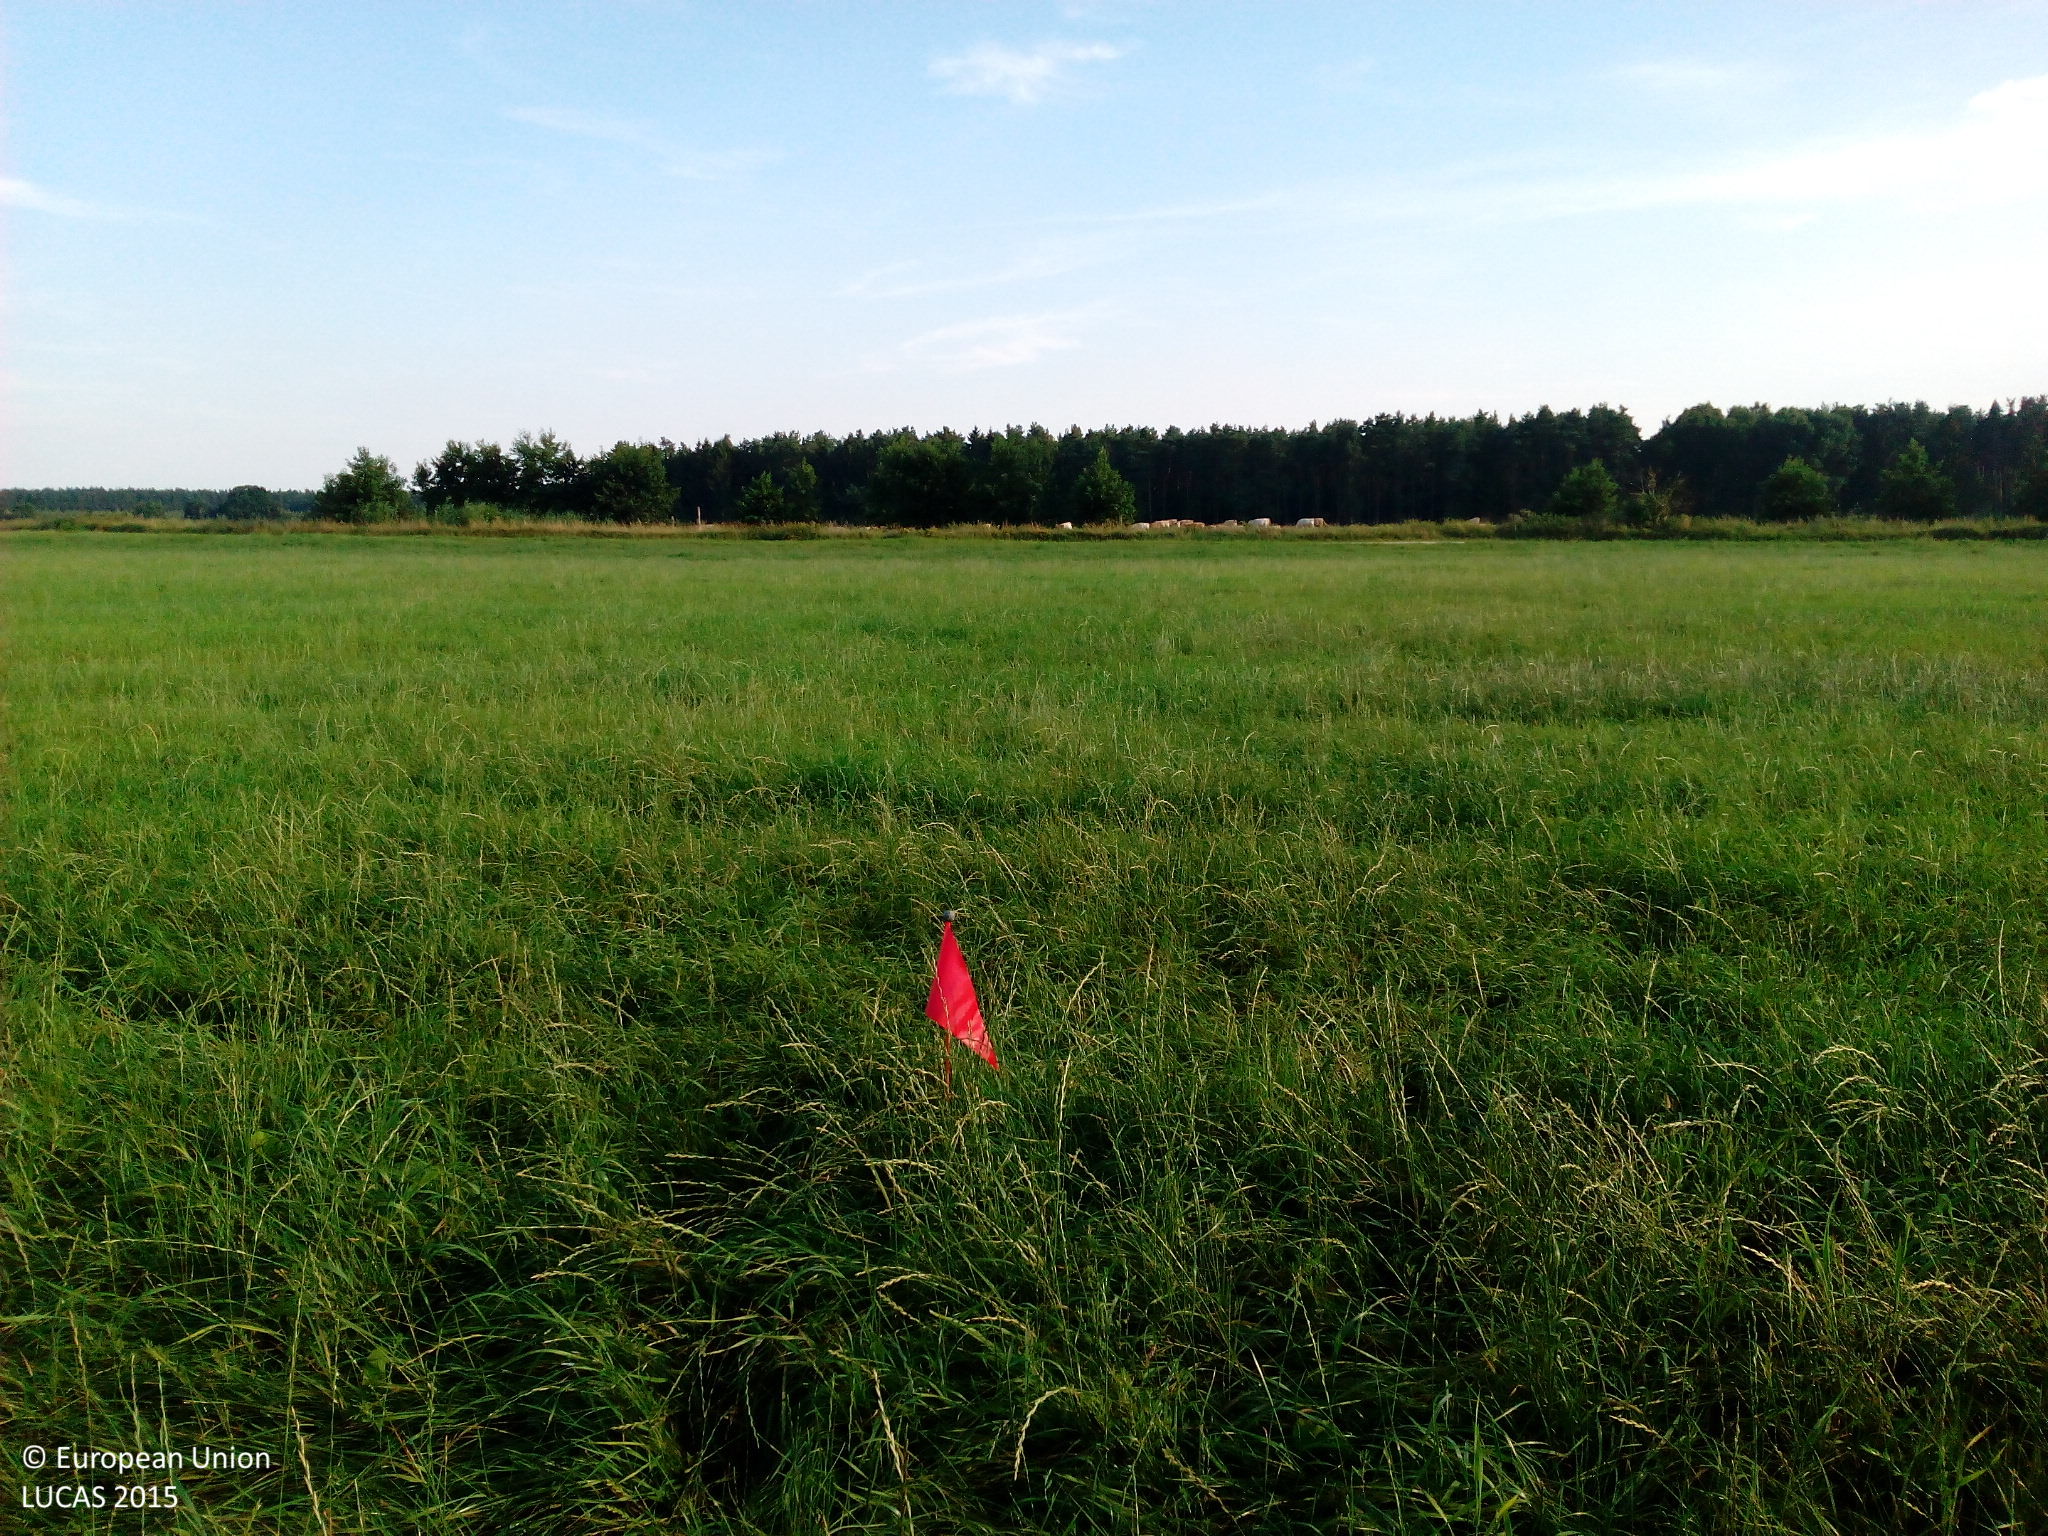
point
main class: Grassland
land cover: Grassland without tree/shrub cover
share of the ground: > 75 %
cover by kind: herbaceous plants 100 %
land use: Agriculture (excluding fallow land and kitchen gardens)
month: August
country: DE
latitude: 53.6341
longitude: 13.6748
